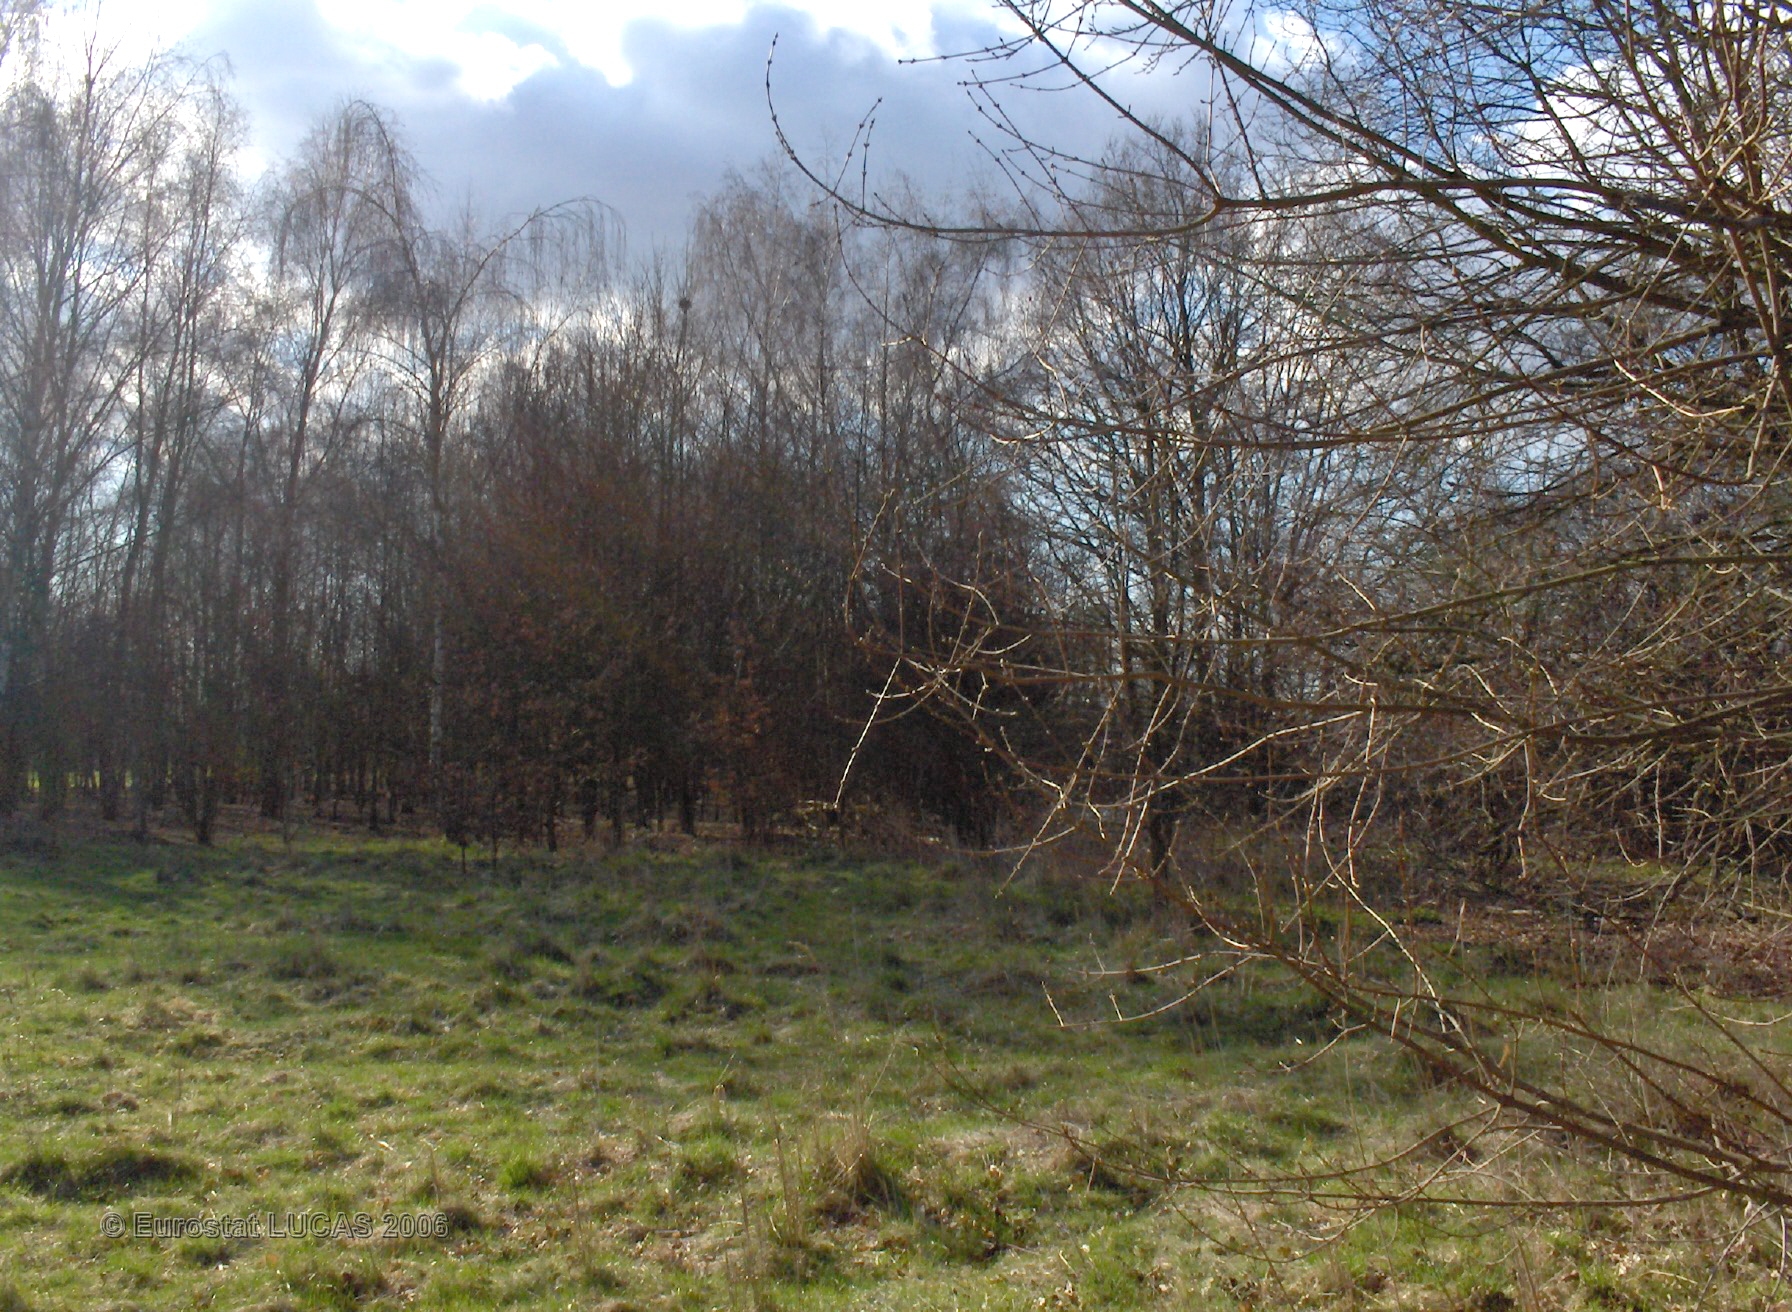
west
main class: Grassland
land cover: Grassland with sparse tree/shrub cover
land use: Agriculture (excluding fallow land and kitchen gardens)
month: April
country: BE
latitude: 51.1657
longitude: 4.4325
